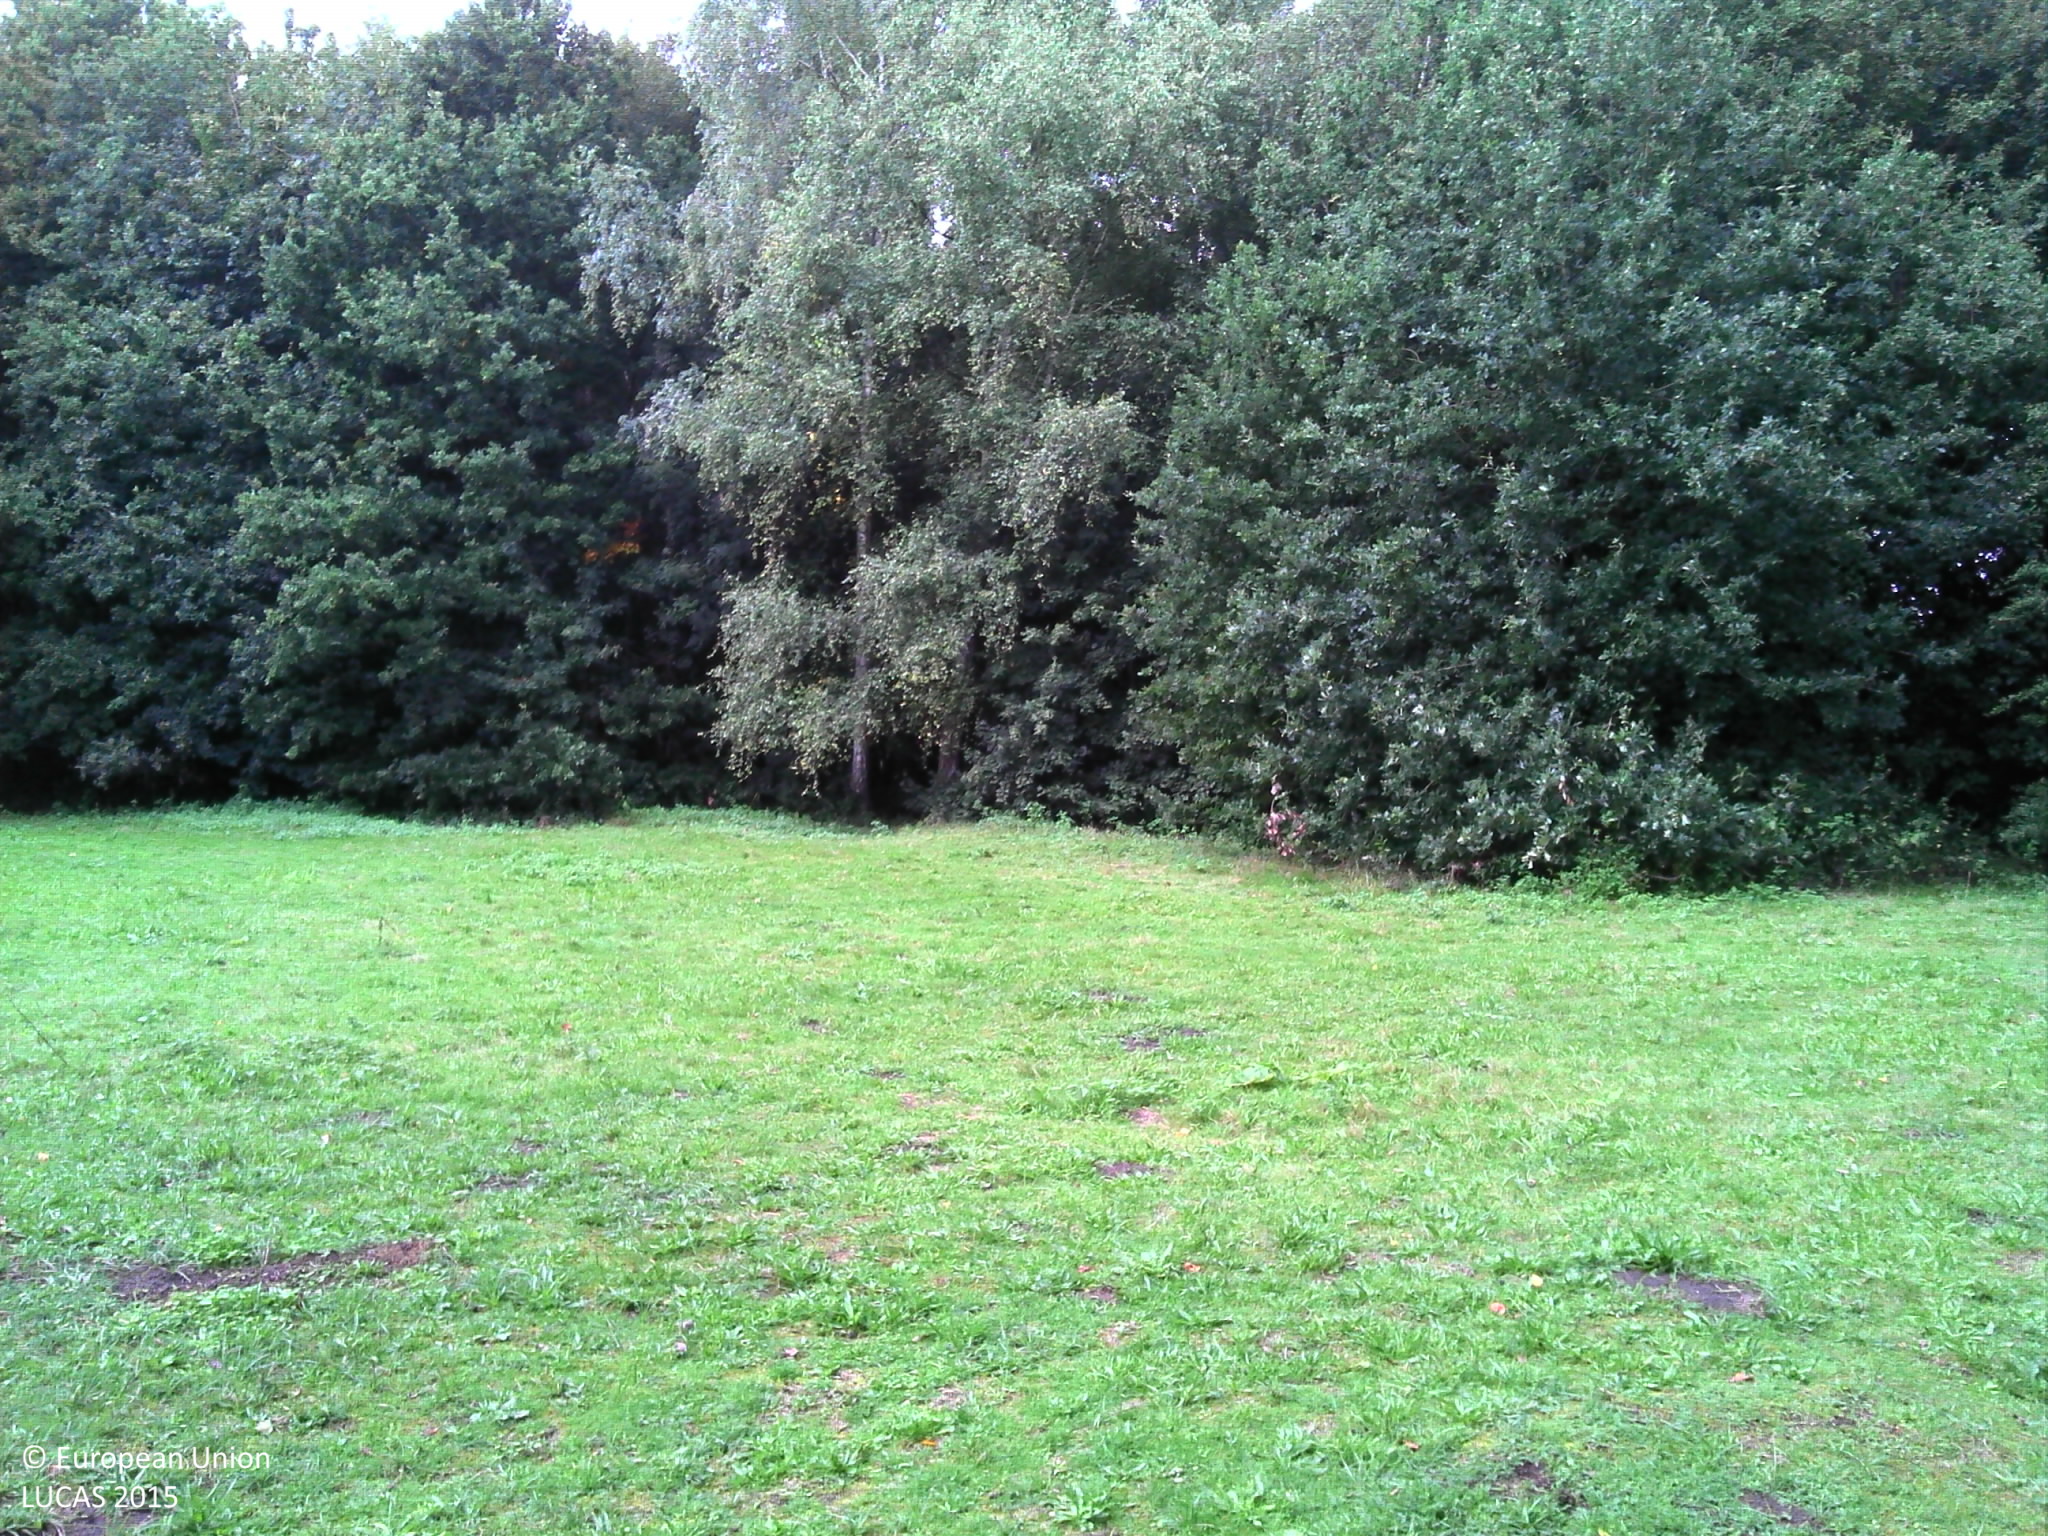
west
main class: Woodland
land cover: Broadleaved woodland
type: mesophytic deciduous forest
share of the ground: > 75 %
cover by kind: broadleaved forest trees 90 %, shrubs 5 %, herbaceous plants 5 %
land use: Amenities, museums, leisure
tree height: > 5 m
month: September
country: BE
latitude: 51.1657
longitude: 4.4325
